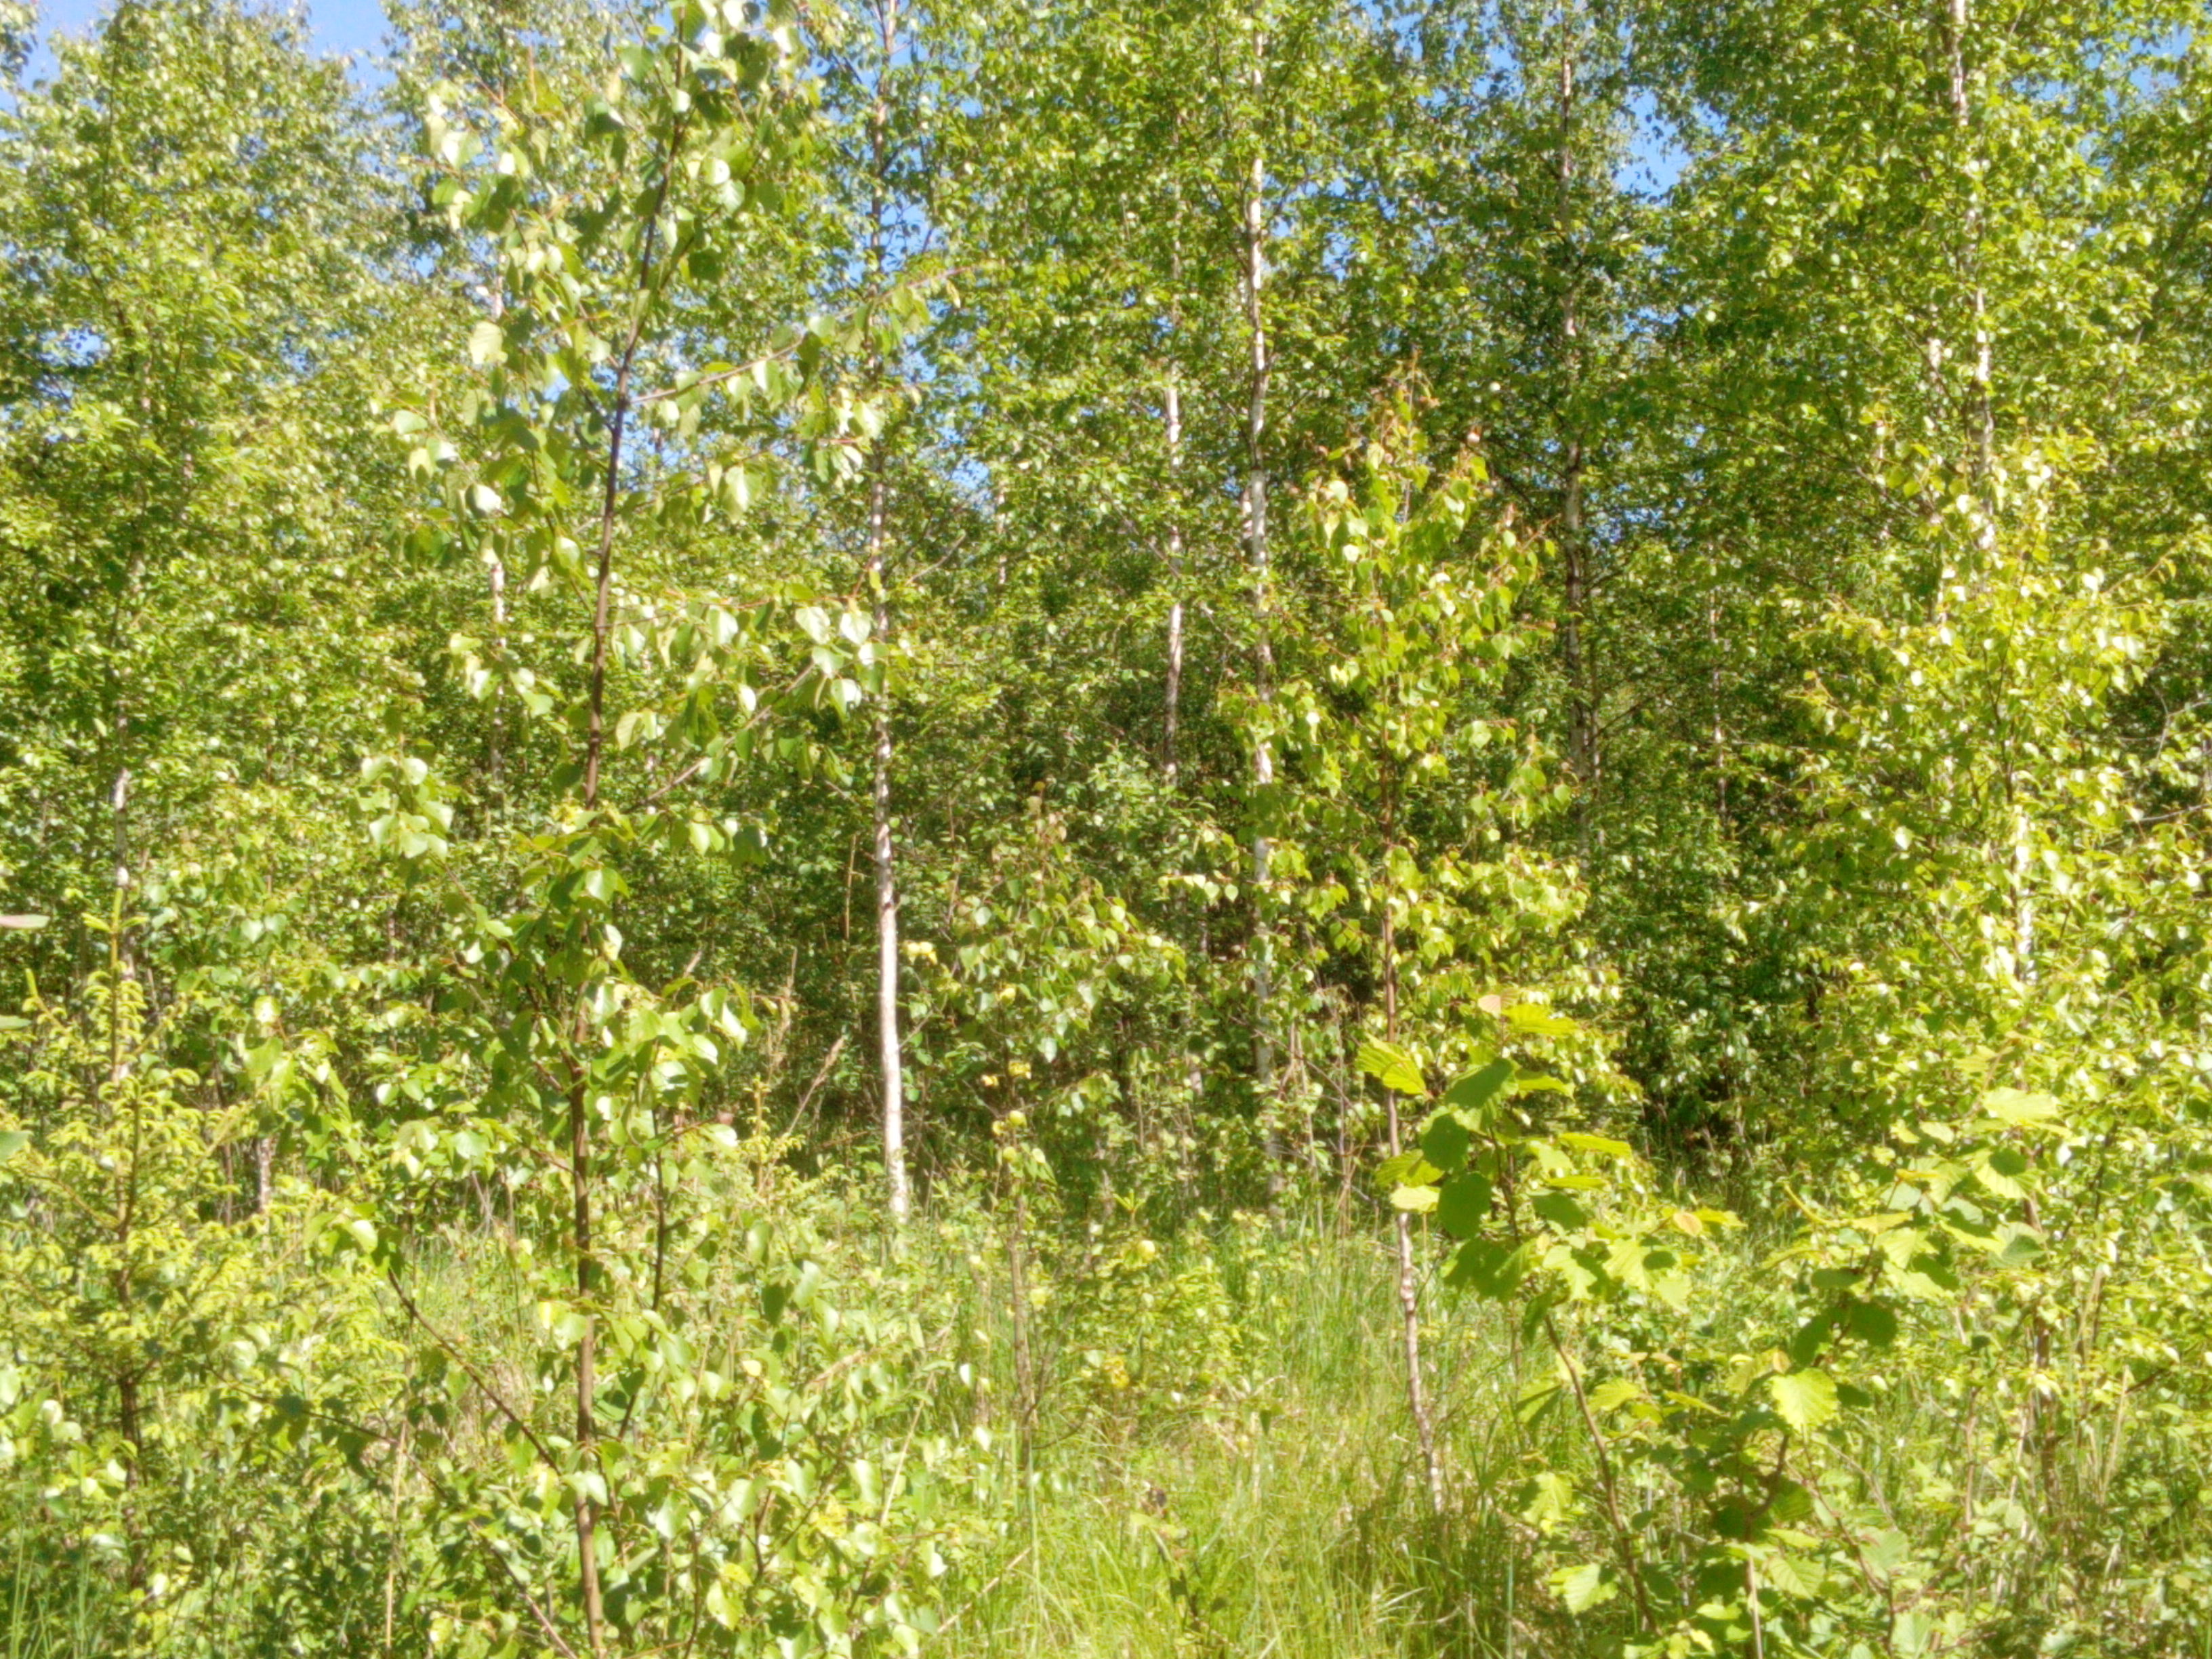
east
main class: Woodland
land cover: Broadleaved woodland
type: non-riverine alder, birch or aspen forest
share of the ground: 50 - 75 %
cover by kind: broadleaved forest trees 50 %, herbaceous plants 40 %, coniferous forest trees 5 %, shrubs 5 %
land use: Forestry
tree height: < 5 m
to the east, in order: Broadleaved woodland
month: June
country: LV
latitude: 56.6202
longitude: 22.2262
